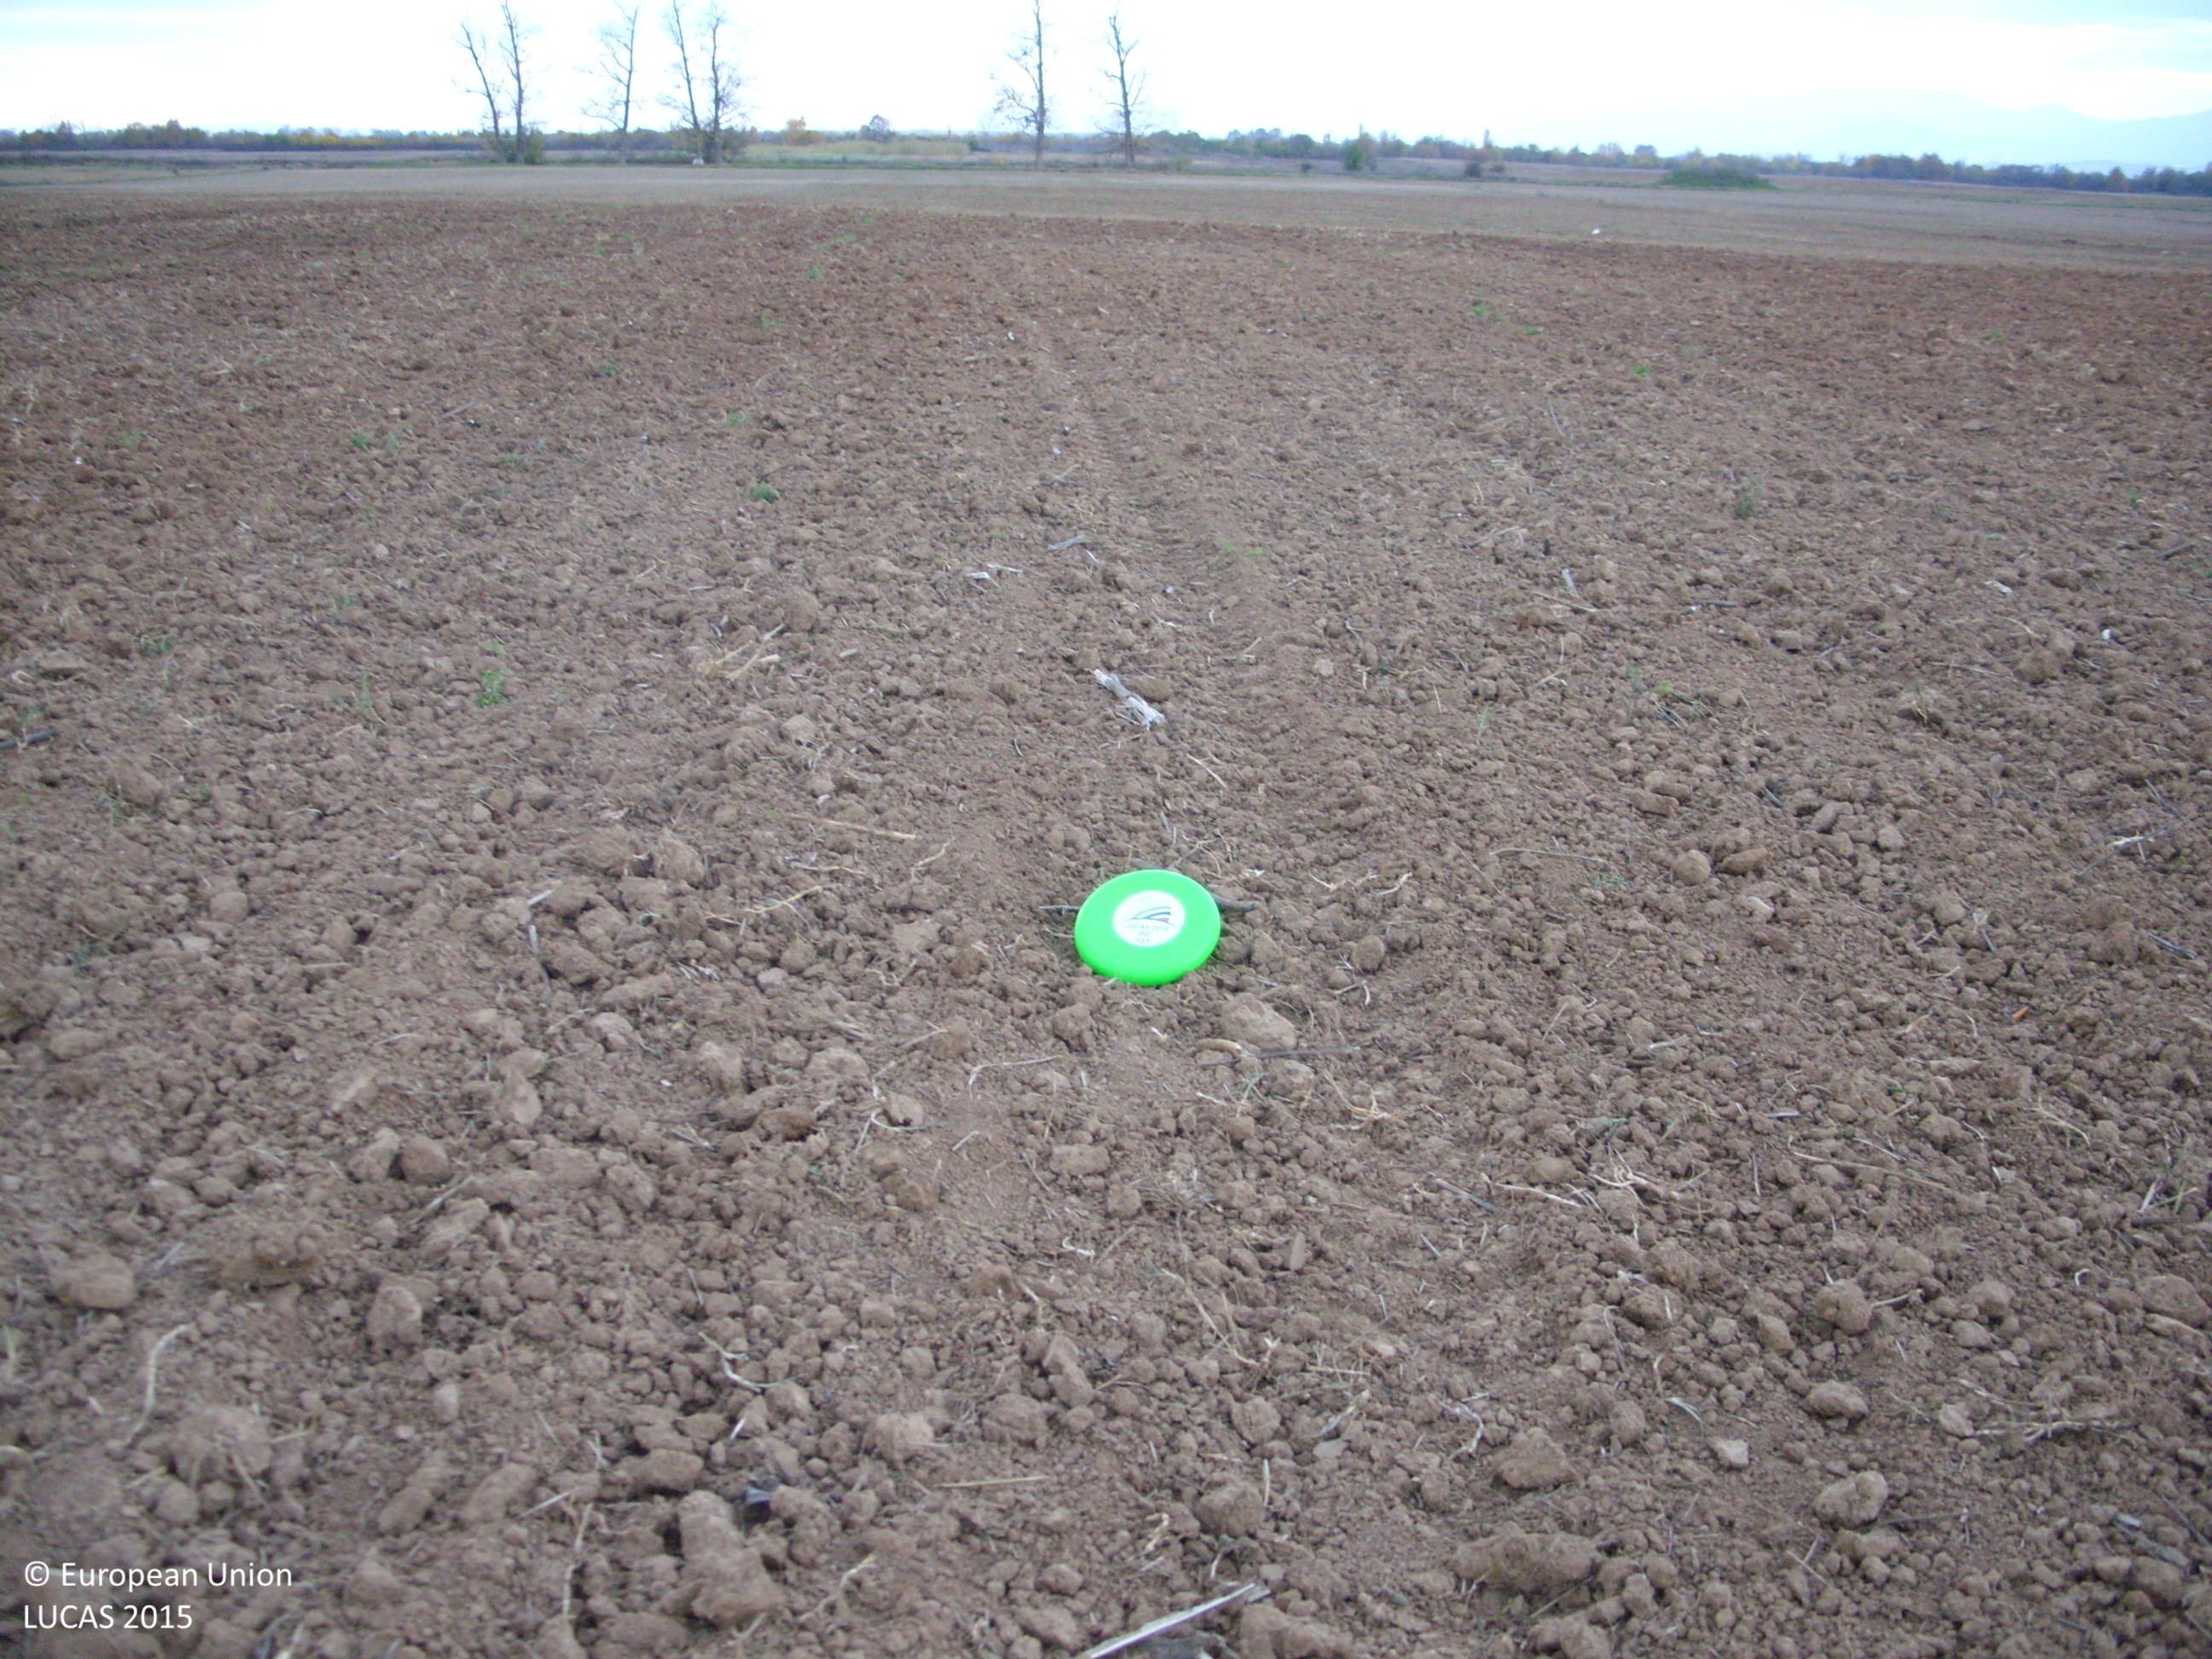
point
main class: Cropland
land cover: Rape and turnip rape
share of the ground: < 10 %
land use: Agriculture (excluding fallow land and kitchen gardens)
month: November
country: BG
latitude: 42.3616
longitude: 24.8320
